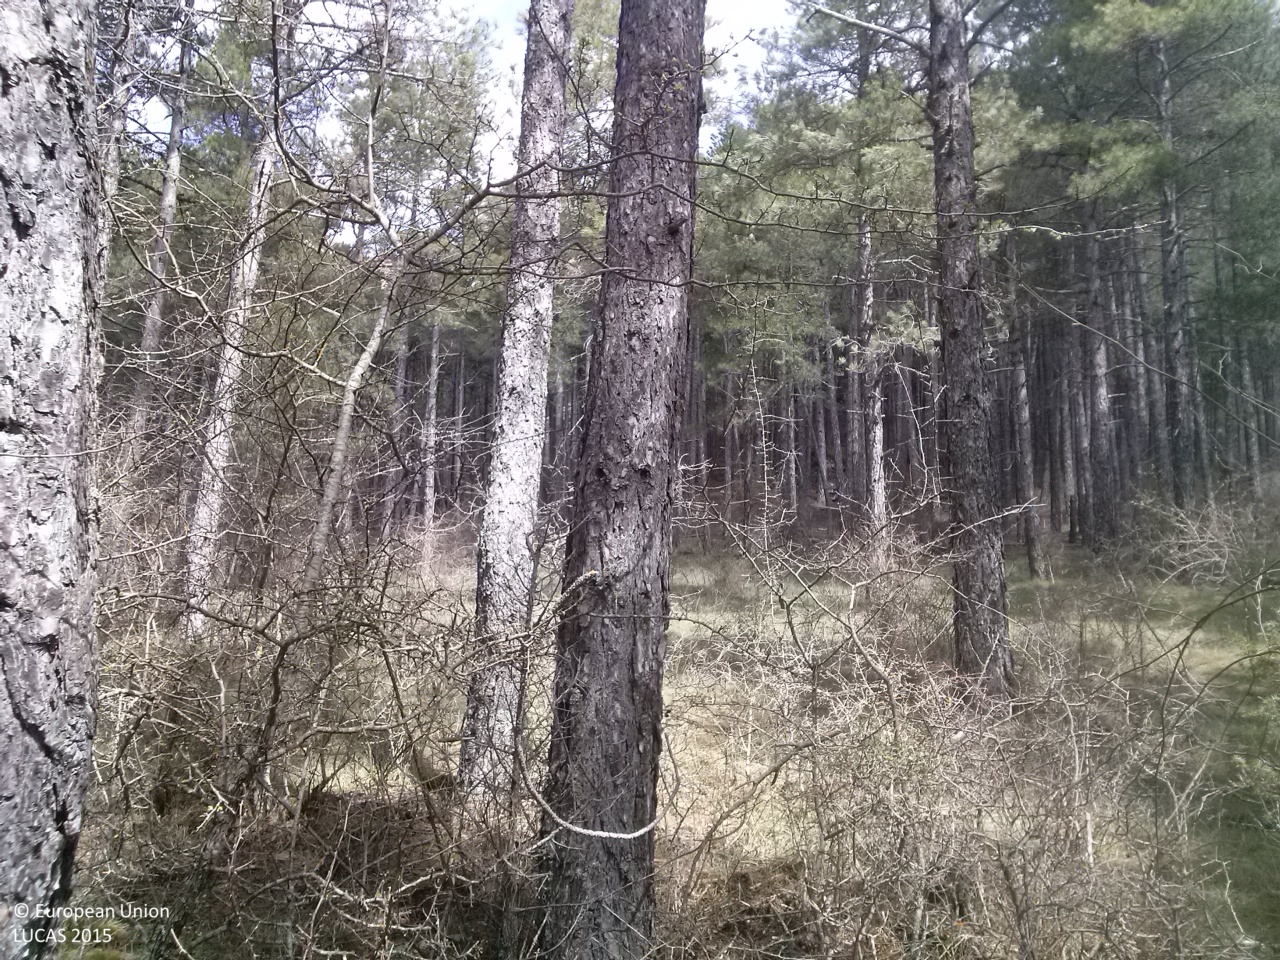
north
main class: Woodland
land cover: Pine dominated coniferous woodland
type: coniferous forest of the mediterranean region
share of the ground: > 75 %
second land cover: Shrubland without tree cover
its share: > 75 %
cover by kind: coniferous forest trees 75 %, shrubs 20 %, herbaceous plants 5 %
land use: Forestry
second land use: Agriculture (excluding fallow land and kitchen gardens)
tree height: > 5 m
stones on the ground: < 10 %
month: April
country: ES
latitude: 40.2168
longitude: -1.8951
